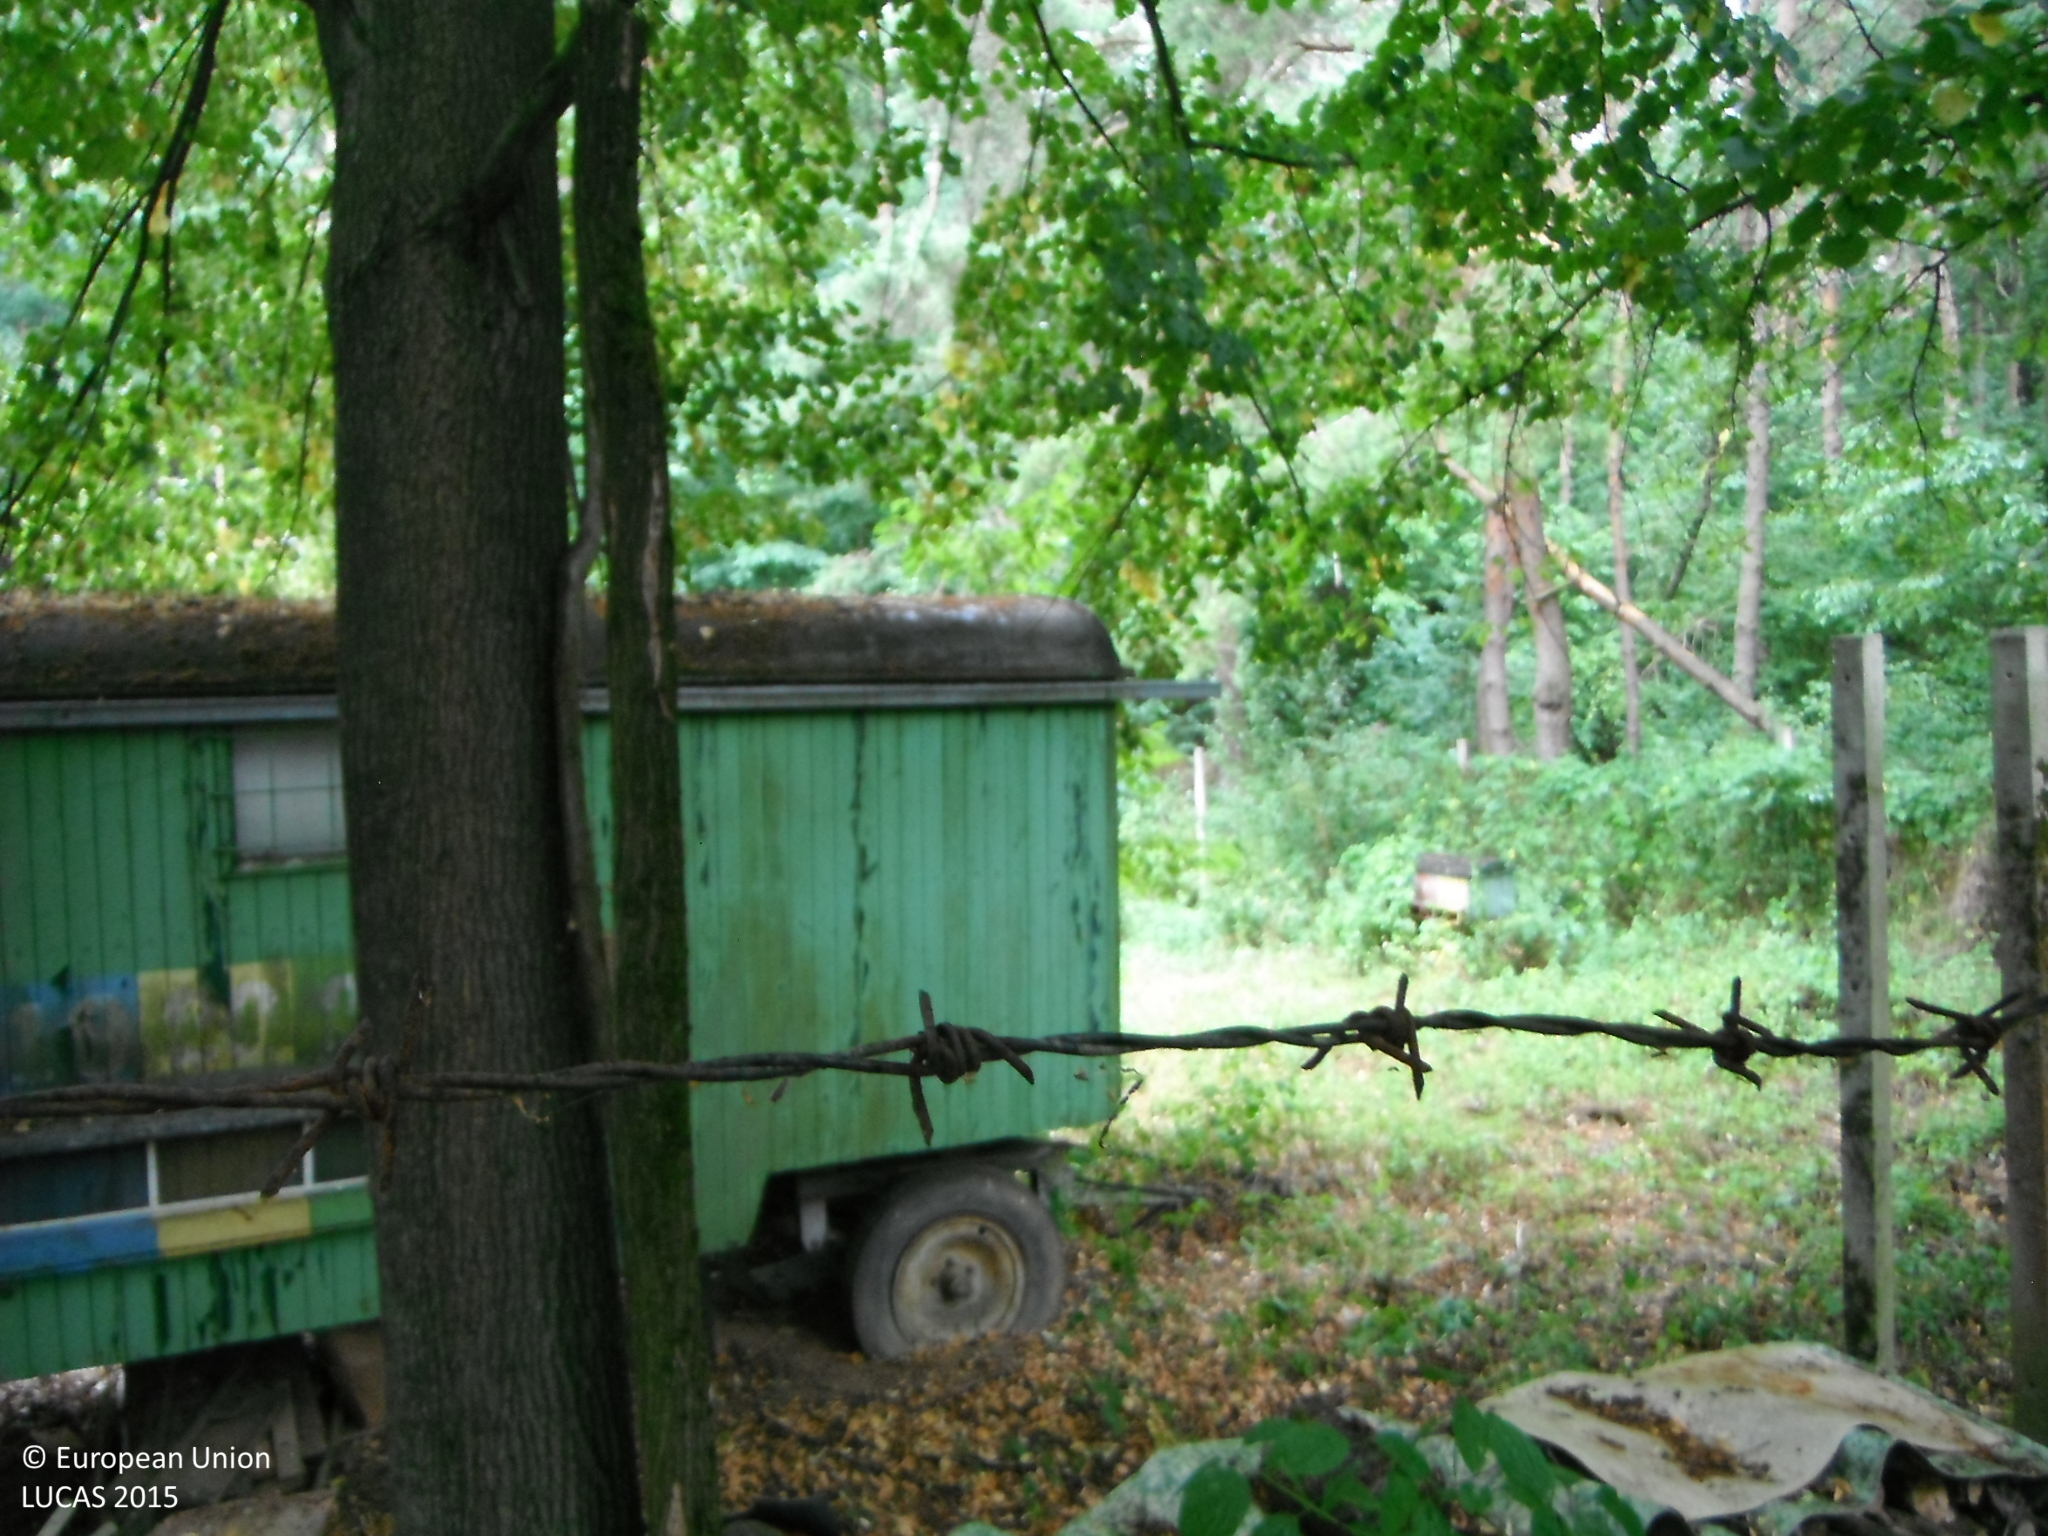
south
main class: Woodland
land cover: Broadleaved woodland
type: mesophytic deciduous forest
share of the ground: > 75 %
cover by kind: broadleaved forest trees 80 %, herbaceous plants 20 %
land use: Forestry
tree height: > 5 m
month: July
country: SK
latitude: 48.6809
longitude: 18.1505
